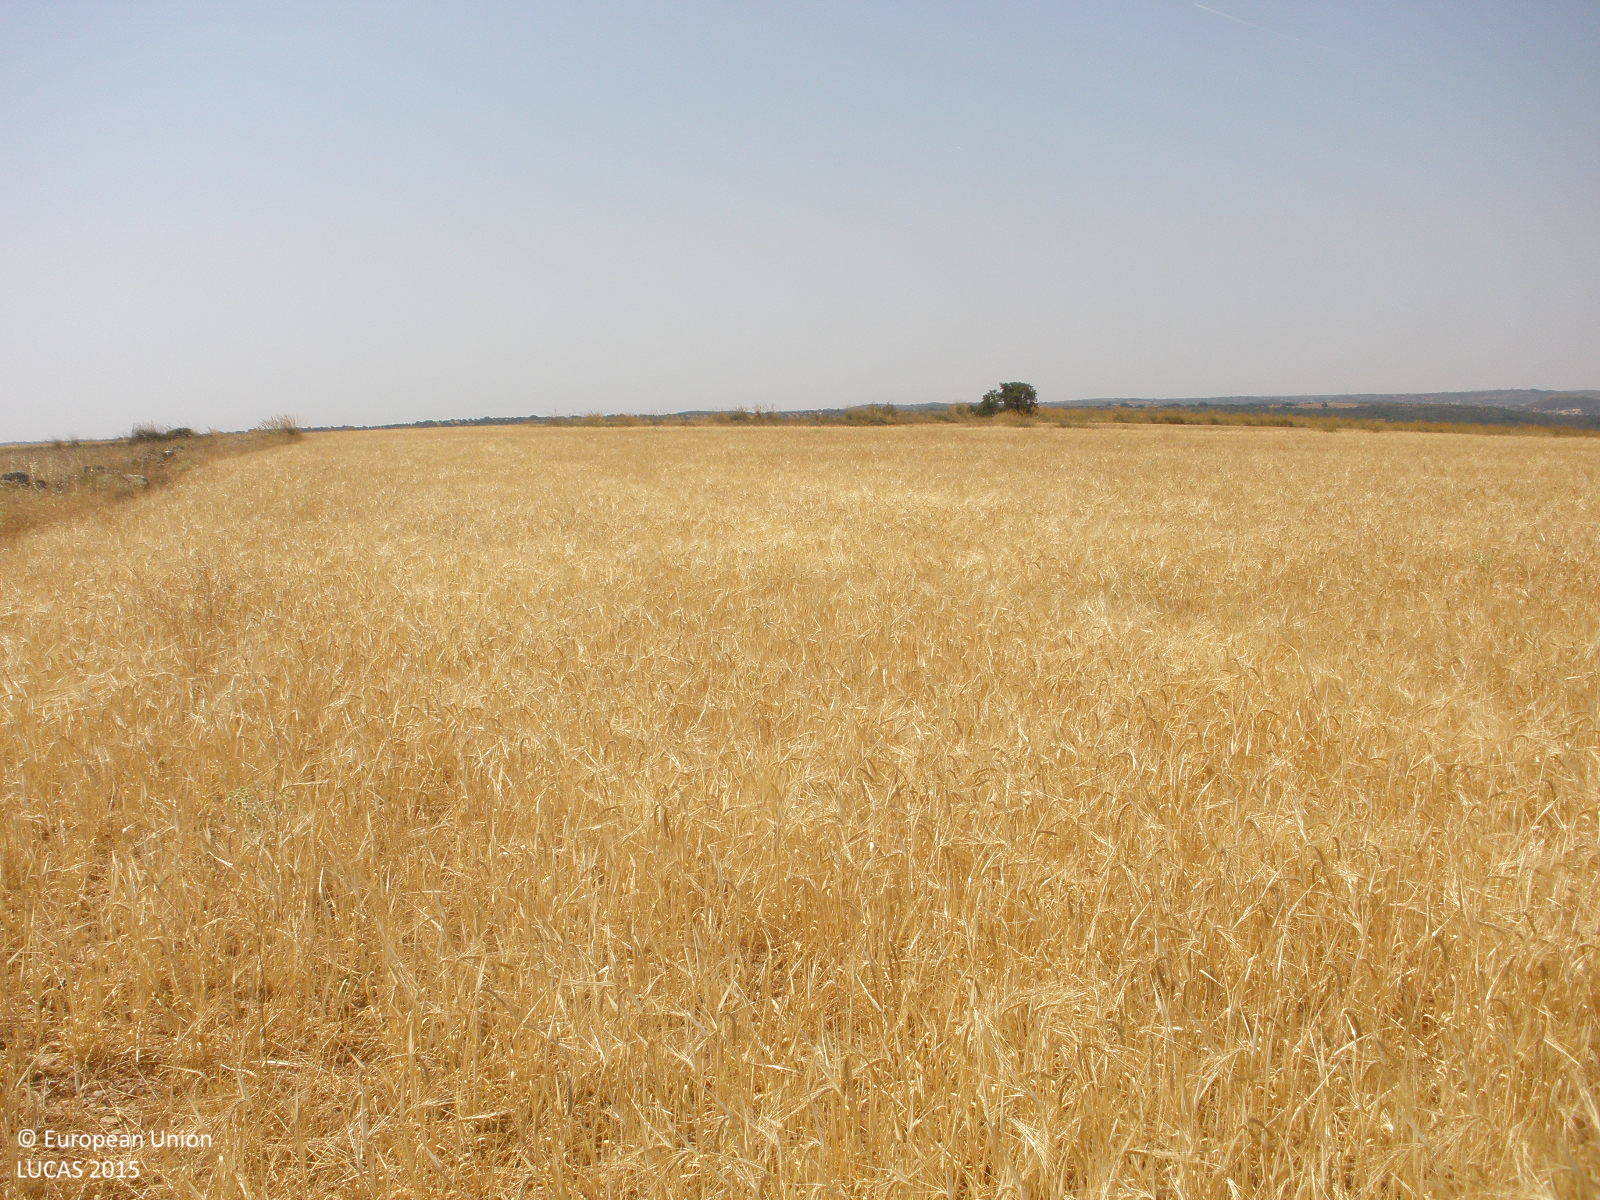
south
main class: Cropland
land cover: Barley
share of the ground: > 75 %
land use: Agriculture (excluding fallow land and kitchen gardens)
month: July
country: ES
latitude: 40.2444
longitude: -3.3733
